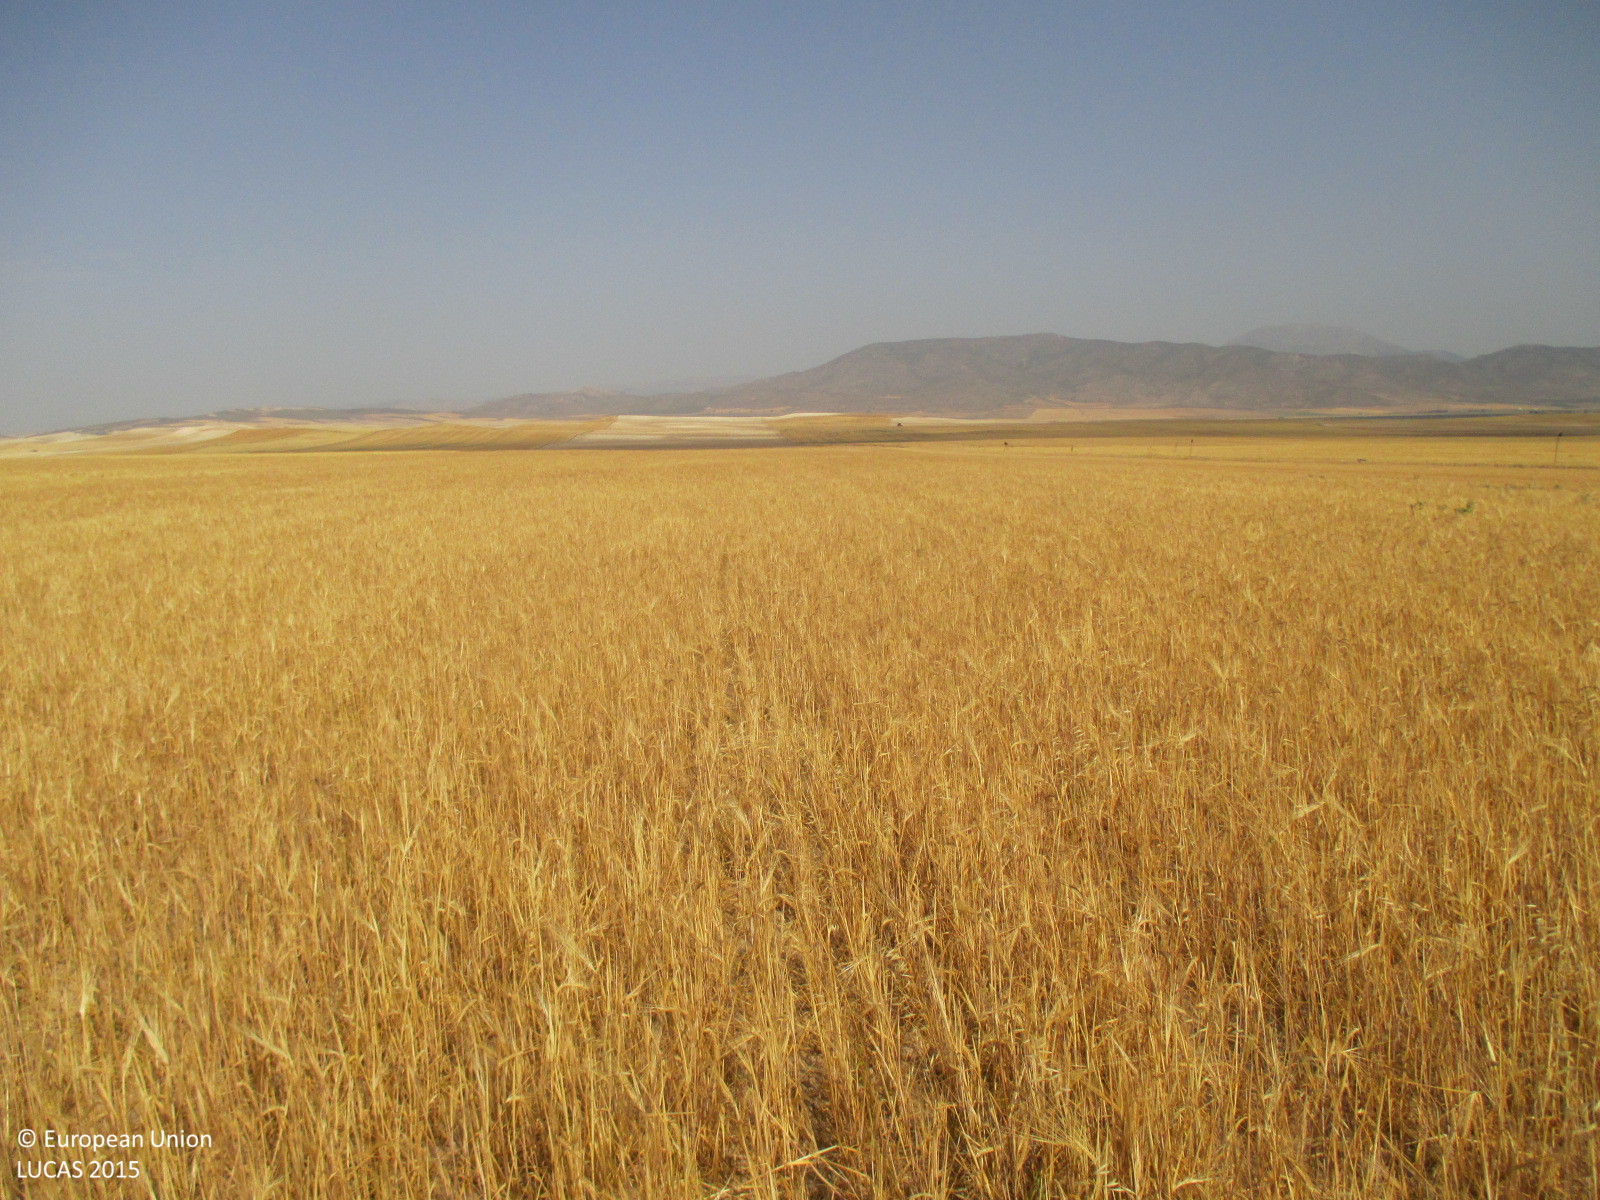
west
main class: Cropland
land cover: Barley
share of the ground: 50 - 75 %
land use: Agriculture (excluding fallow land and kitchen gardens)
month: July
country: ES
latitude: 37.7936
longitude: -2.4010
